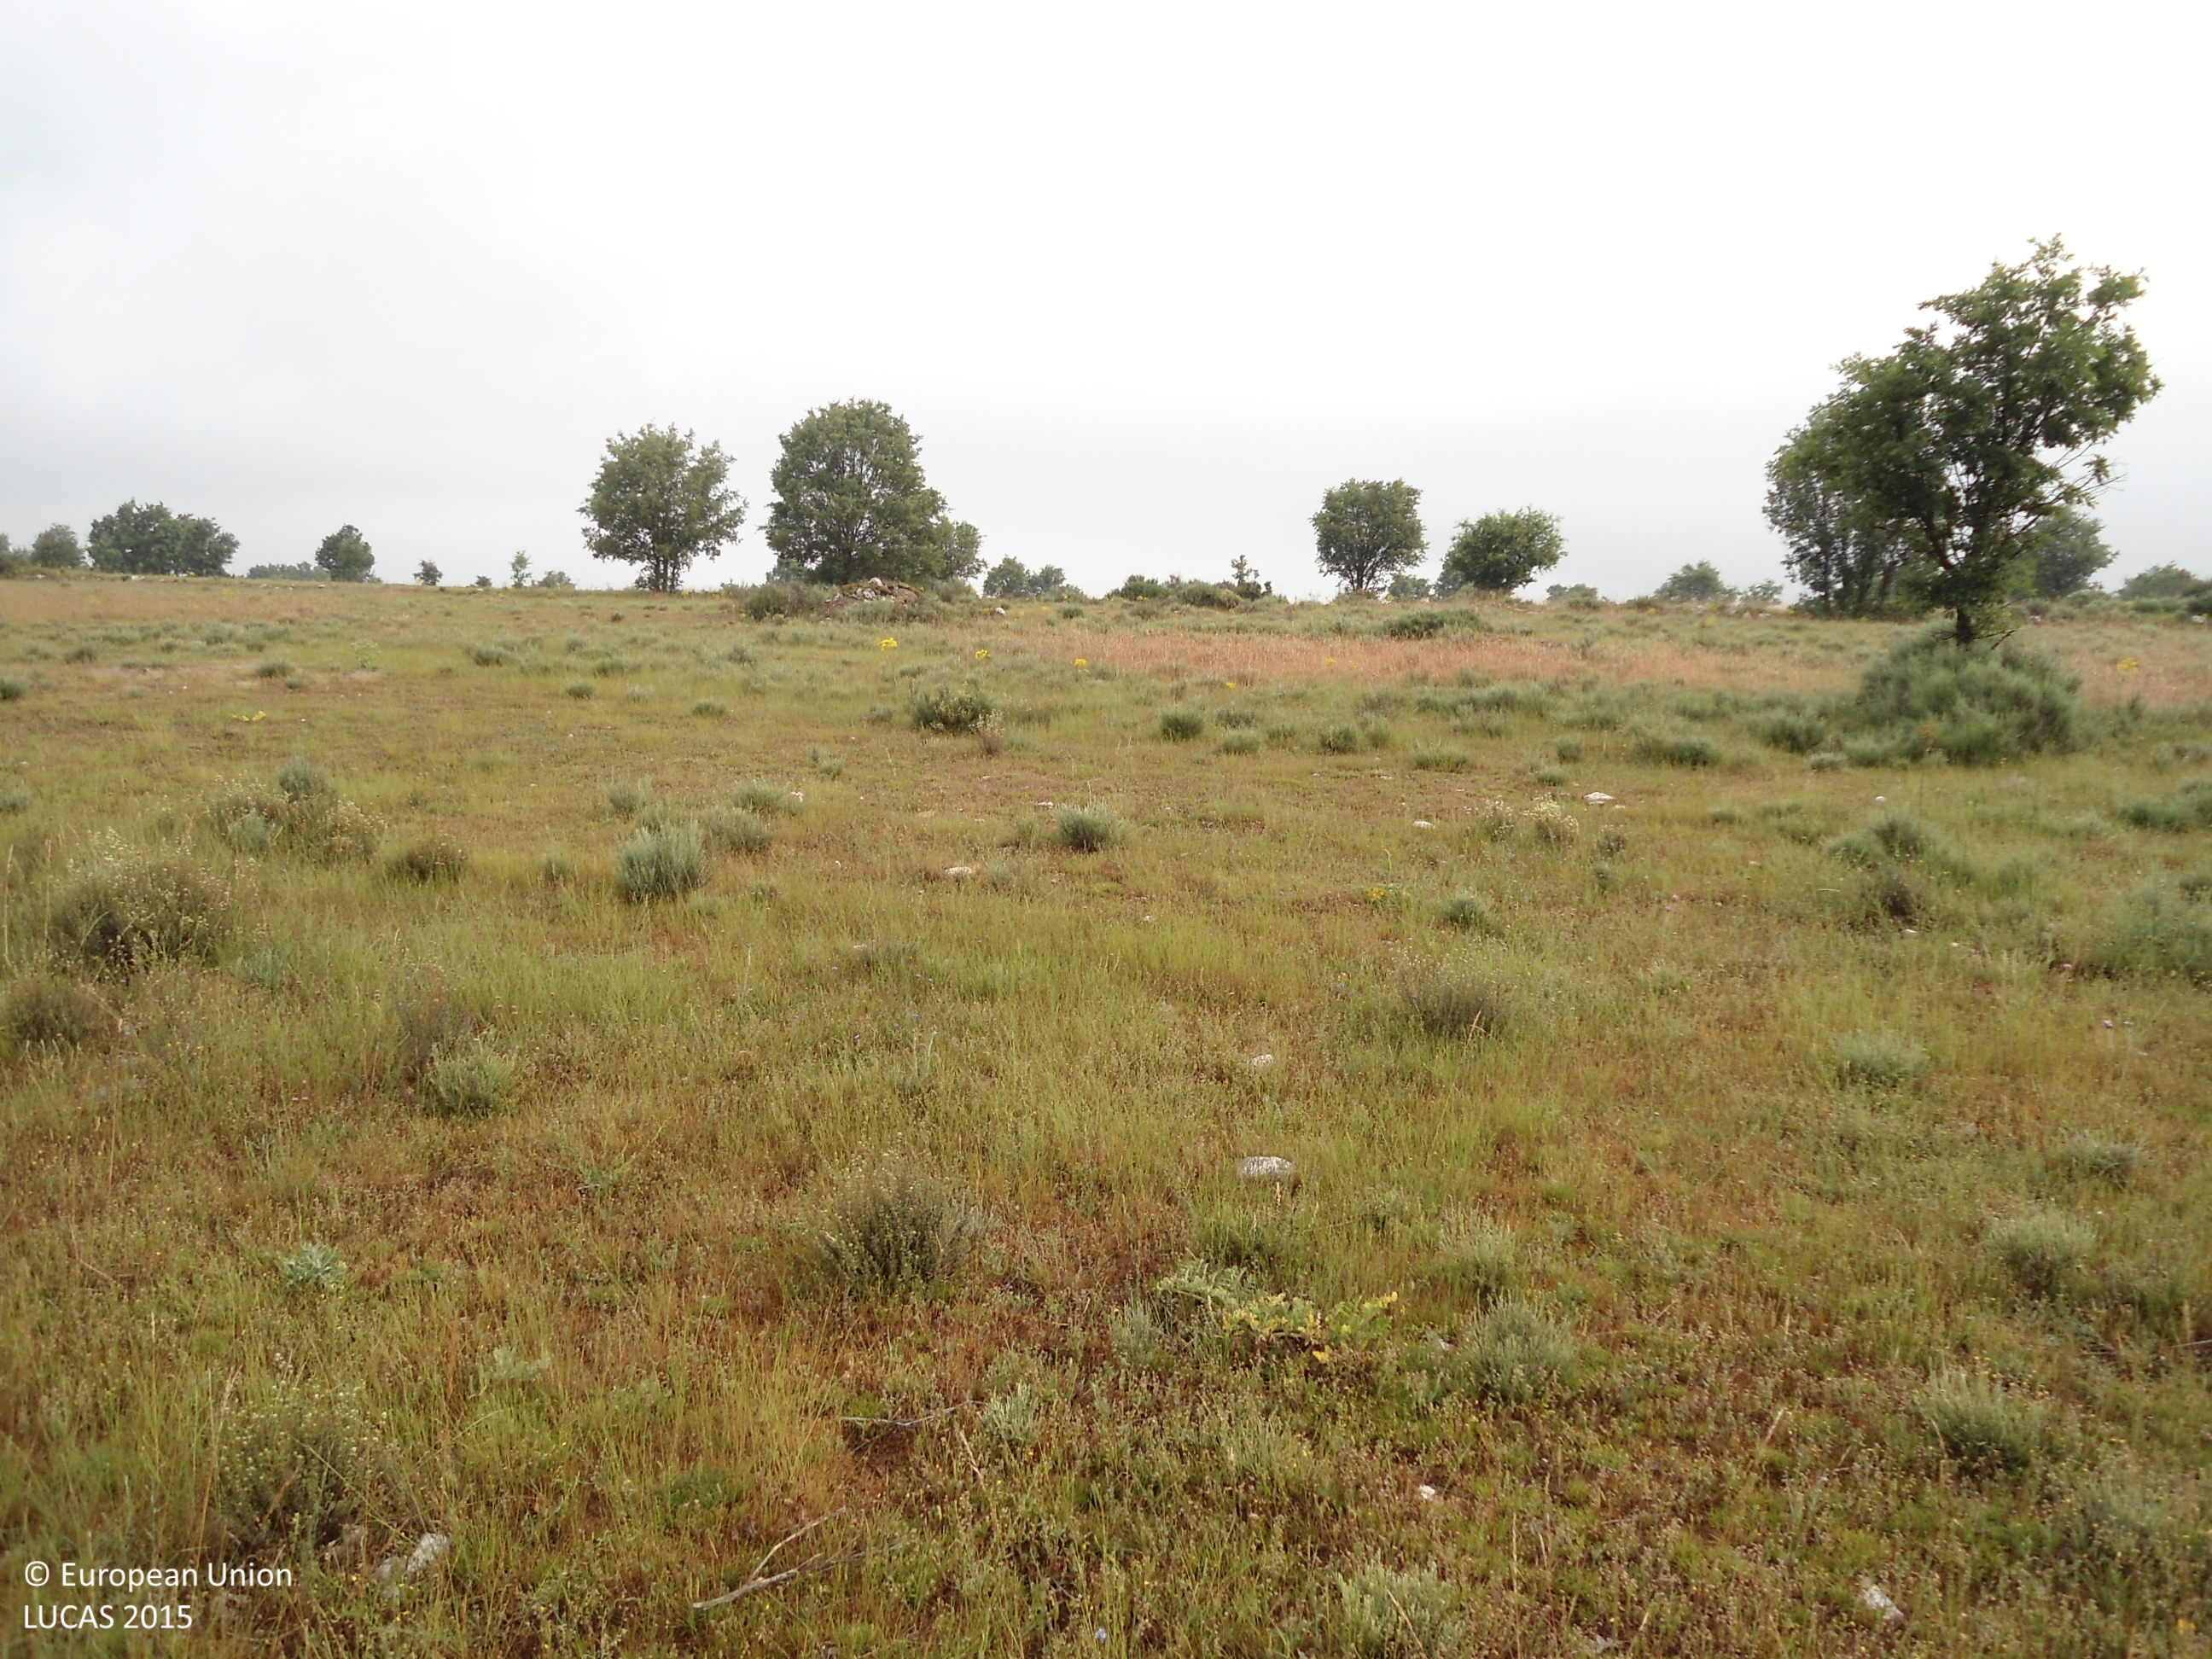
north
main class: Grassland
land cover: Grassland with sparse tree/shrub cover
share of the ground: > 75 %
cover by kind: herbaceous plants 85 %, shrubs 10 %, broadleaved forest trees 5 %
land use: Agriculture (excluding fallow land and kitchen gardens)
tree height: > 5 m
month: June
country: ES
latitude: 42.0531
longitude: -6.3340
